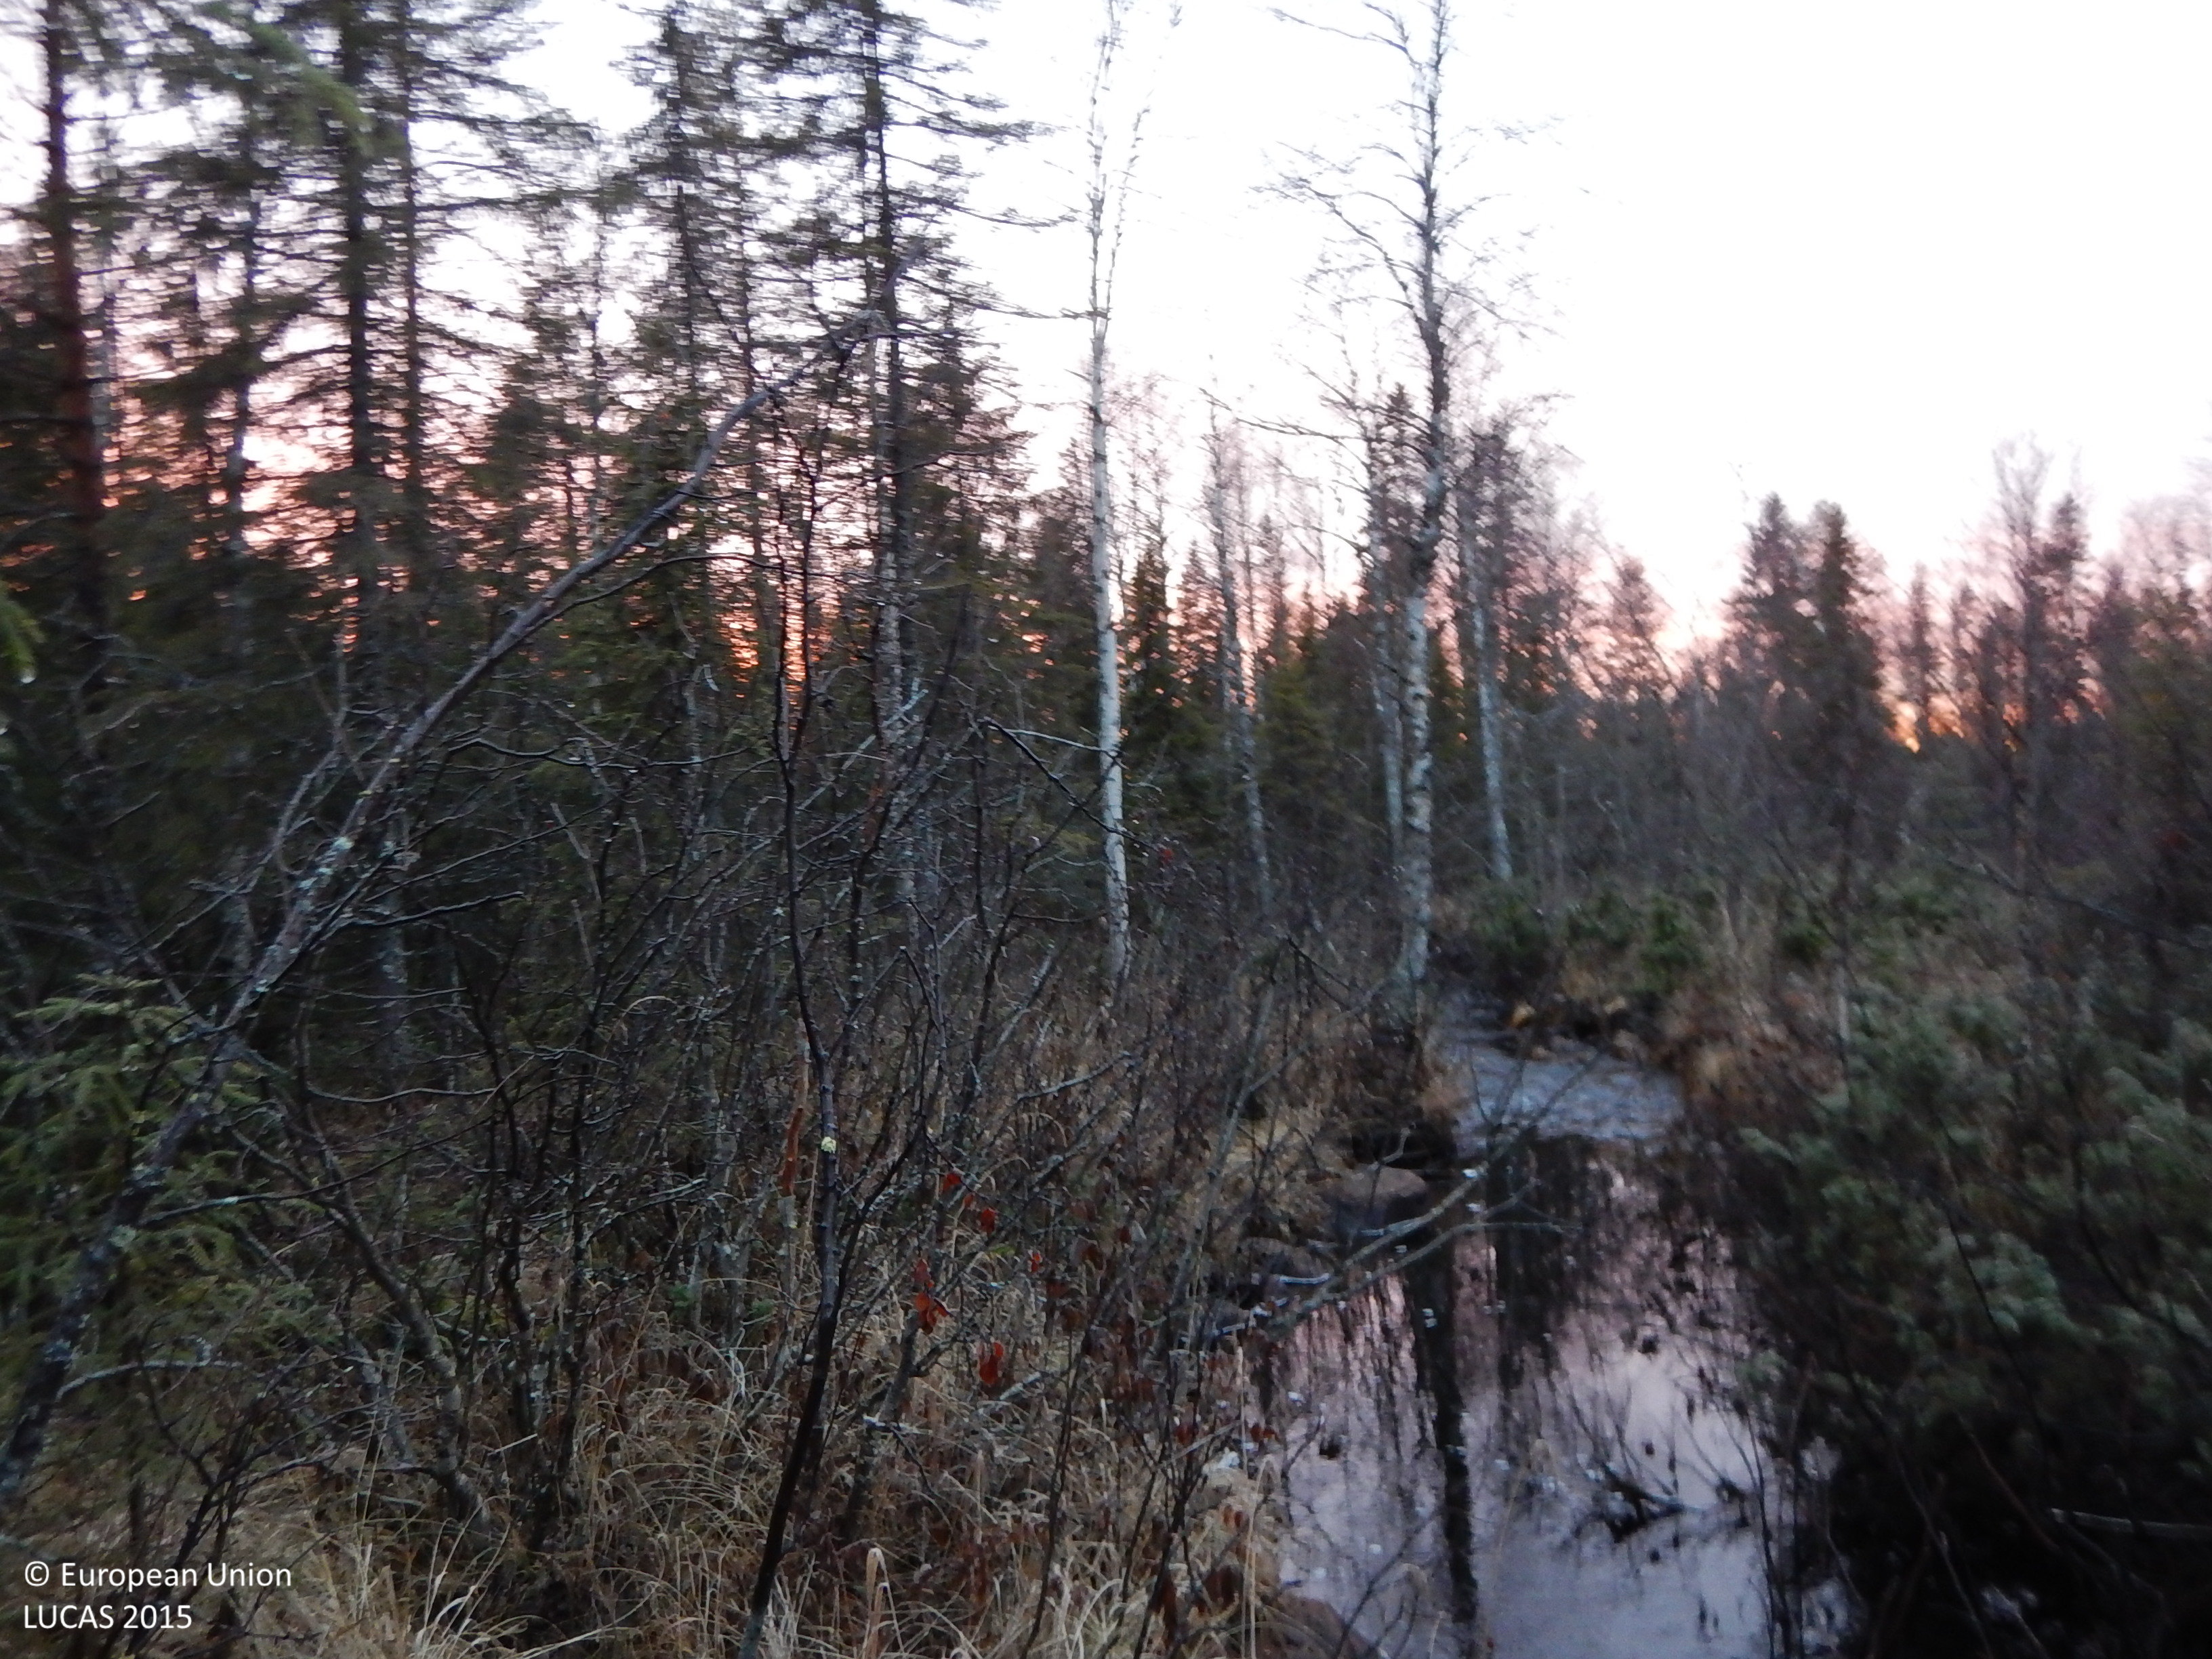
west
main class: Woodland
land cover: Broadleaved woodland
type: mire and swamp forests
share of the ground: 25 - 50 %
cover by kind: broadleaved forest trees 35 %, shrubs 20 %, herbaceous plants 20 %, lichens and mosses 20 %, coniferous forest trees 5 %
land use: Forestry
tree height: > 5 m
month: November
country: SE
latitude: 65.1457
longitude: 20.4828
